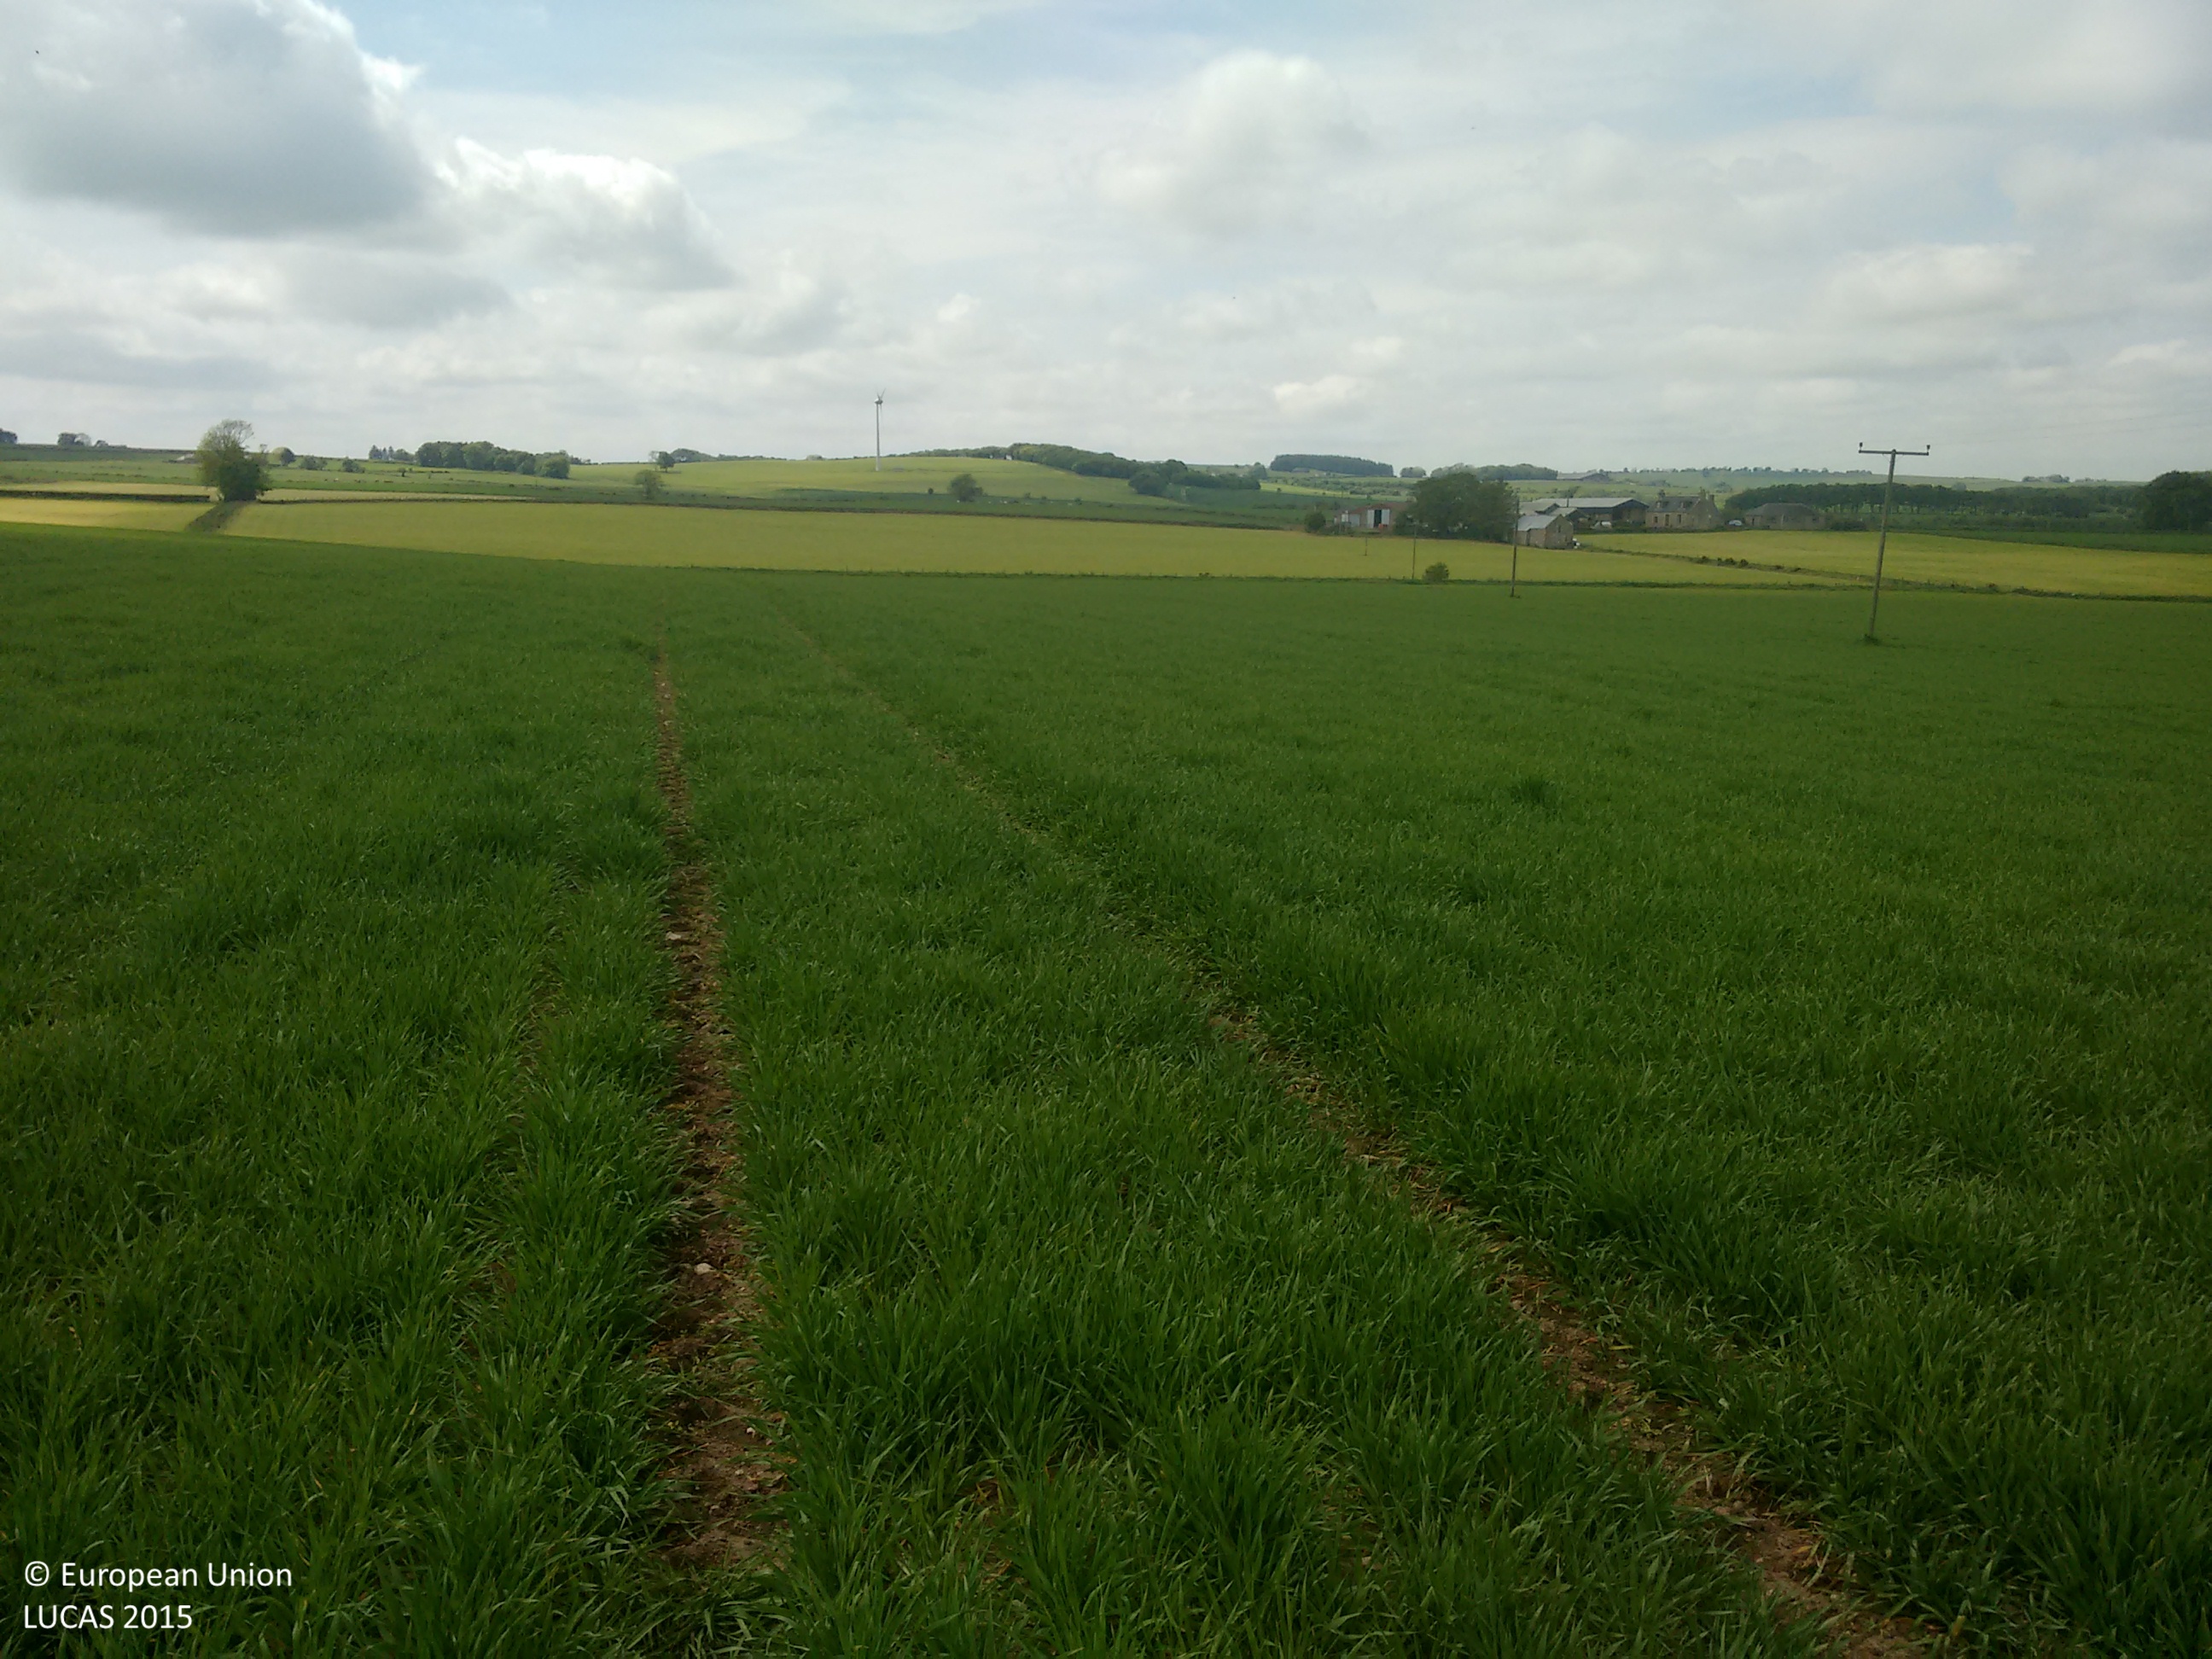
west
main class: Cropland
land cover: Barley
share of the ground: 50 - 75 %
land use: Agriculture (excluding fallow land and kitchen gardens)
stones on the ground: < 10 %
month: June
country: GB
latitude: 57.3132
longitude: -2.2188
